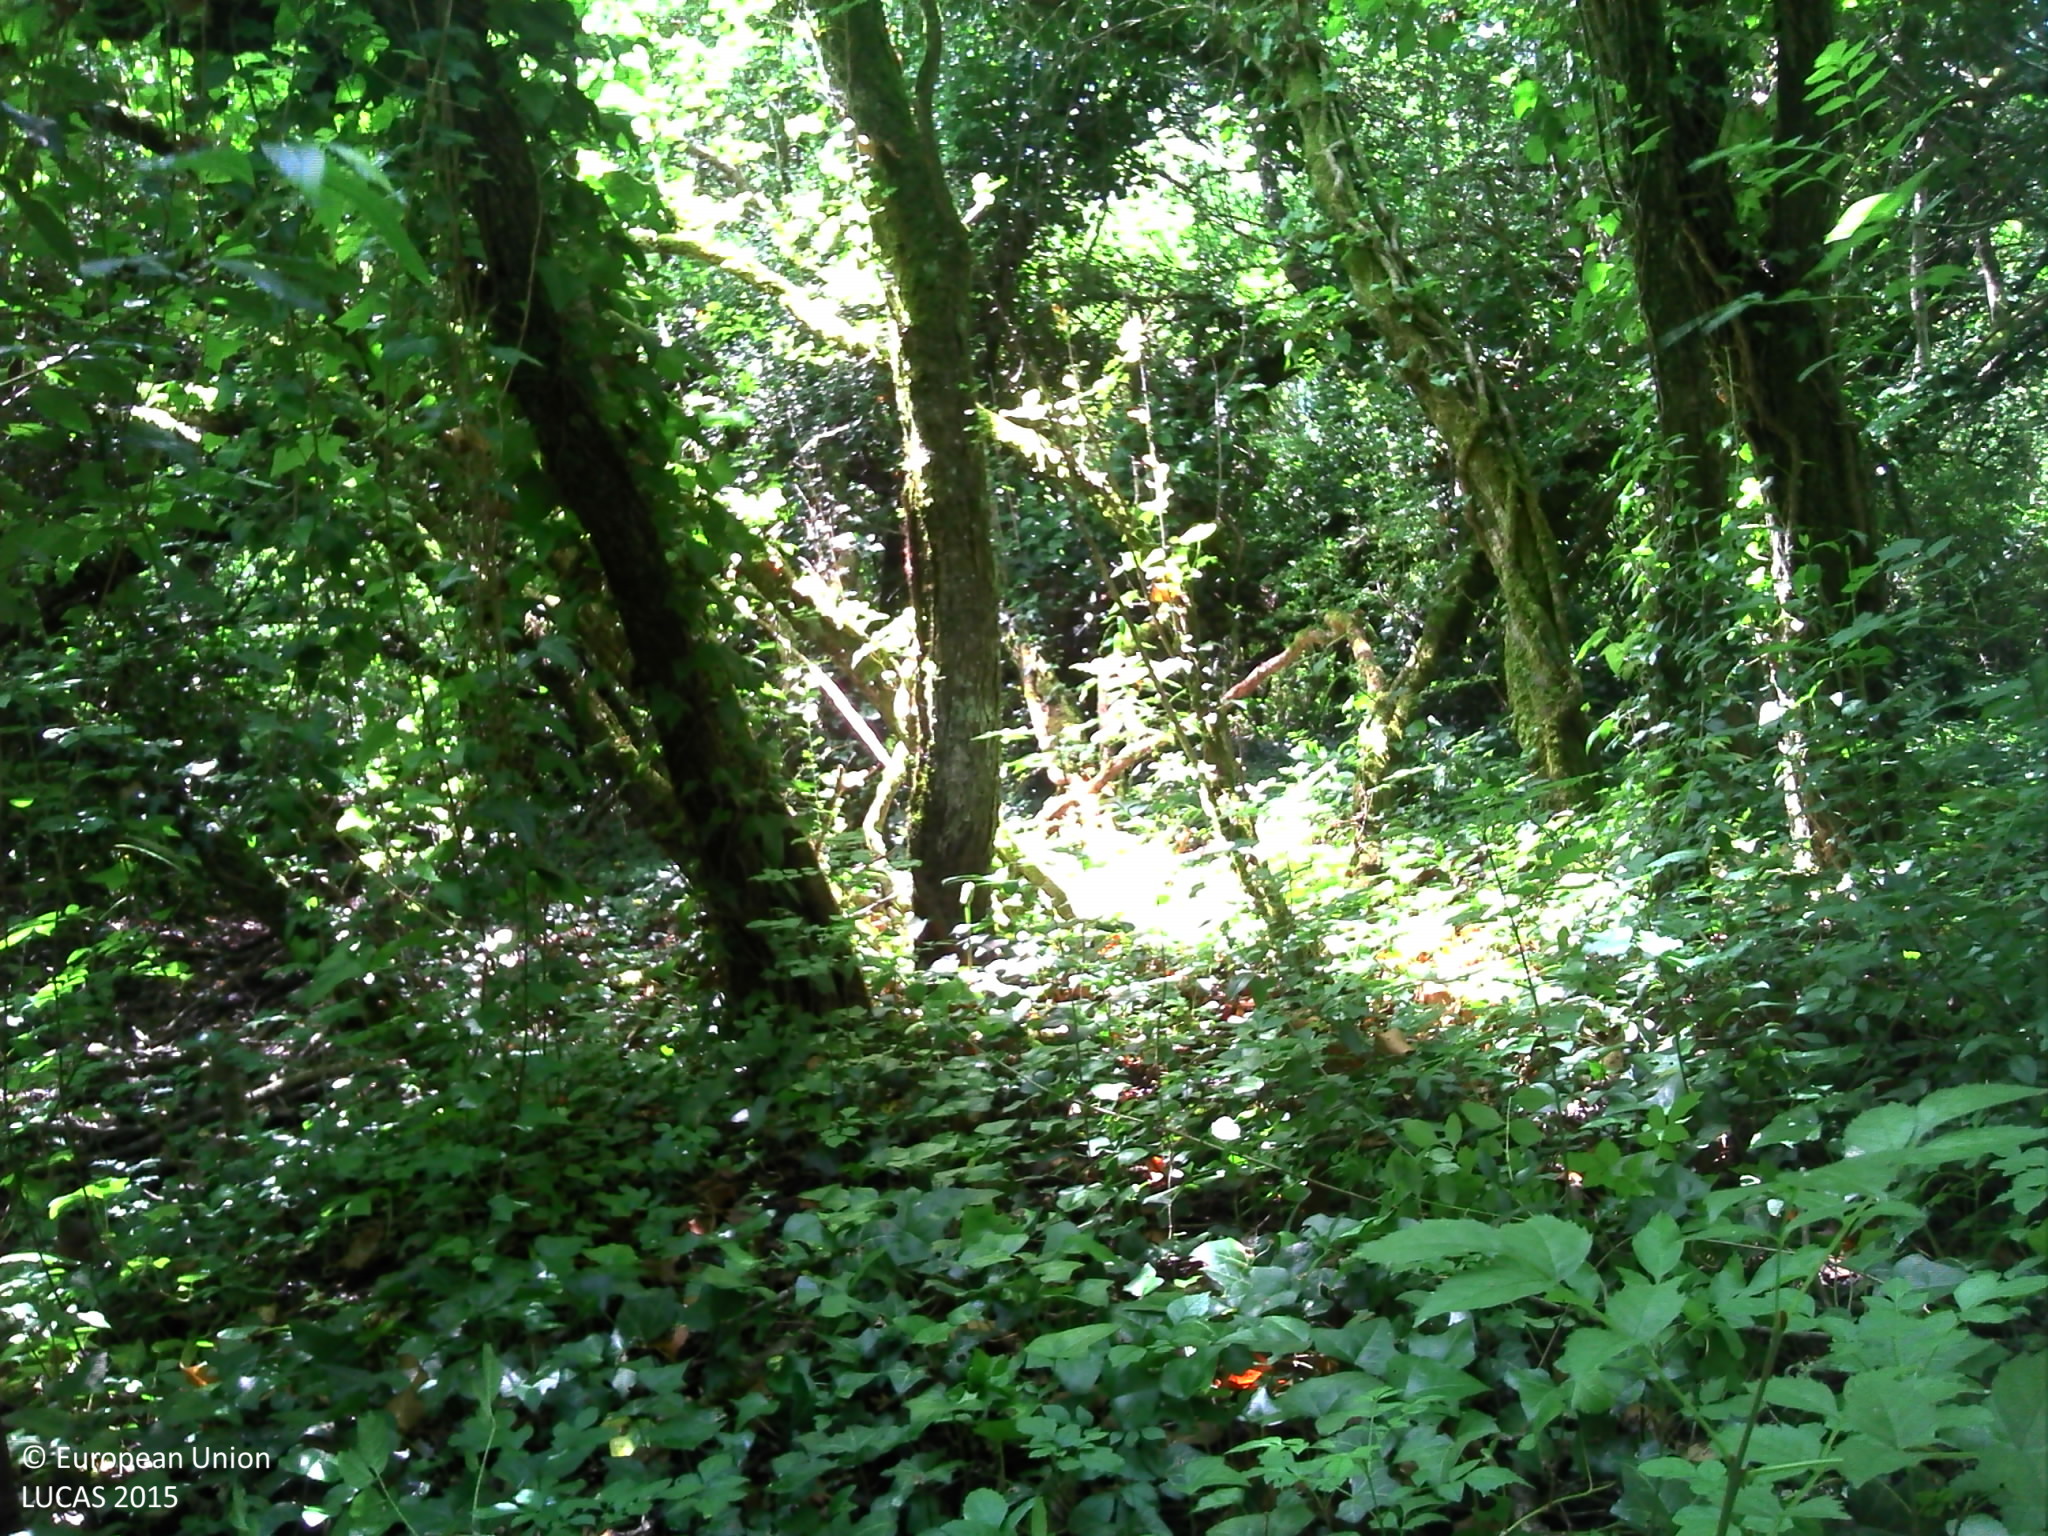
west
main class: Woodland
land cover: Broadleaved woodland
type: mesophytic deciduous forest
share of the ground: > 75 %
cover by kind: broadleaved forest trees 100 %
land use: Forestry
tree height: > 5 m
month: June
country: FR
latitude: 45.7305
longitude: -1.1449
